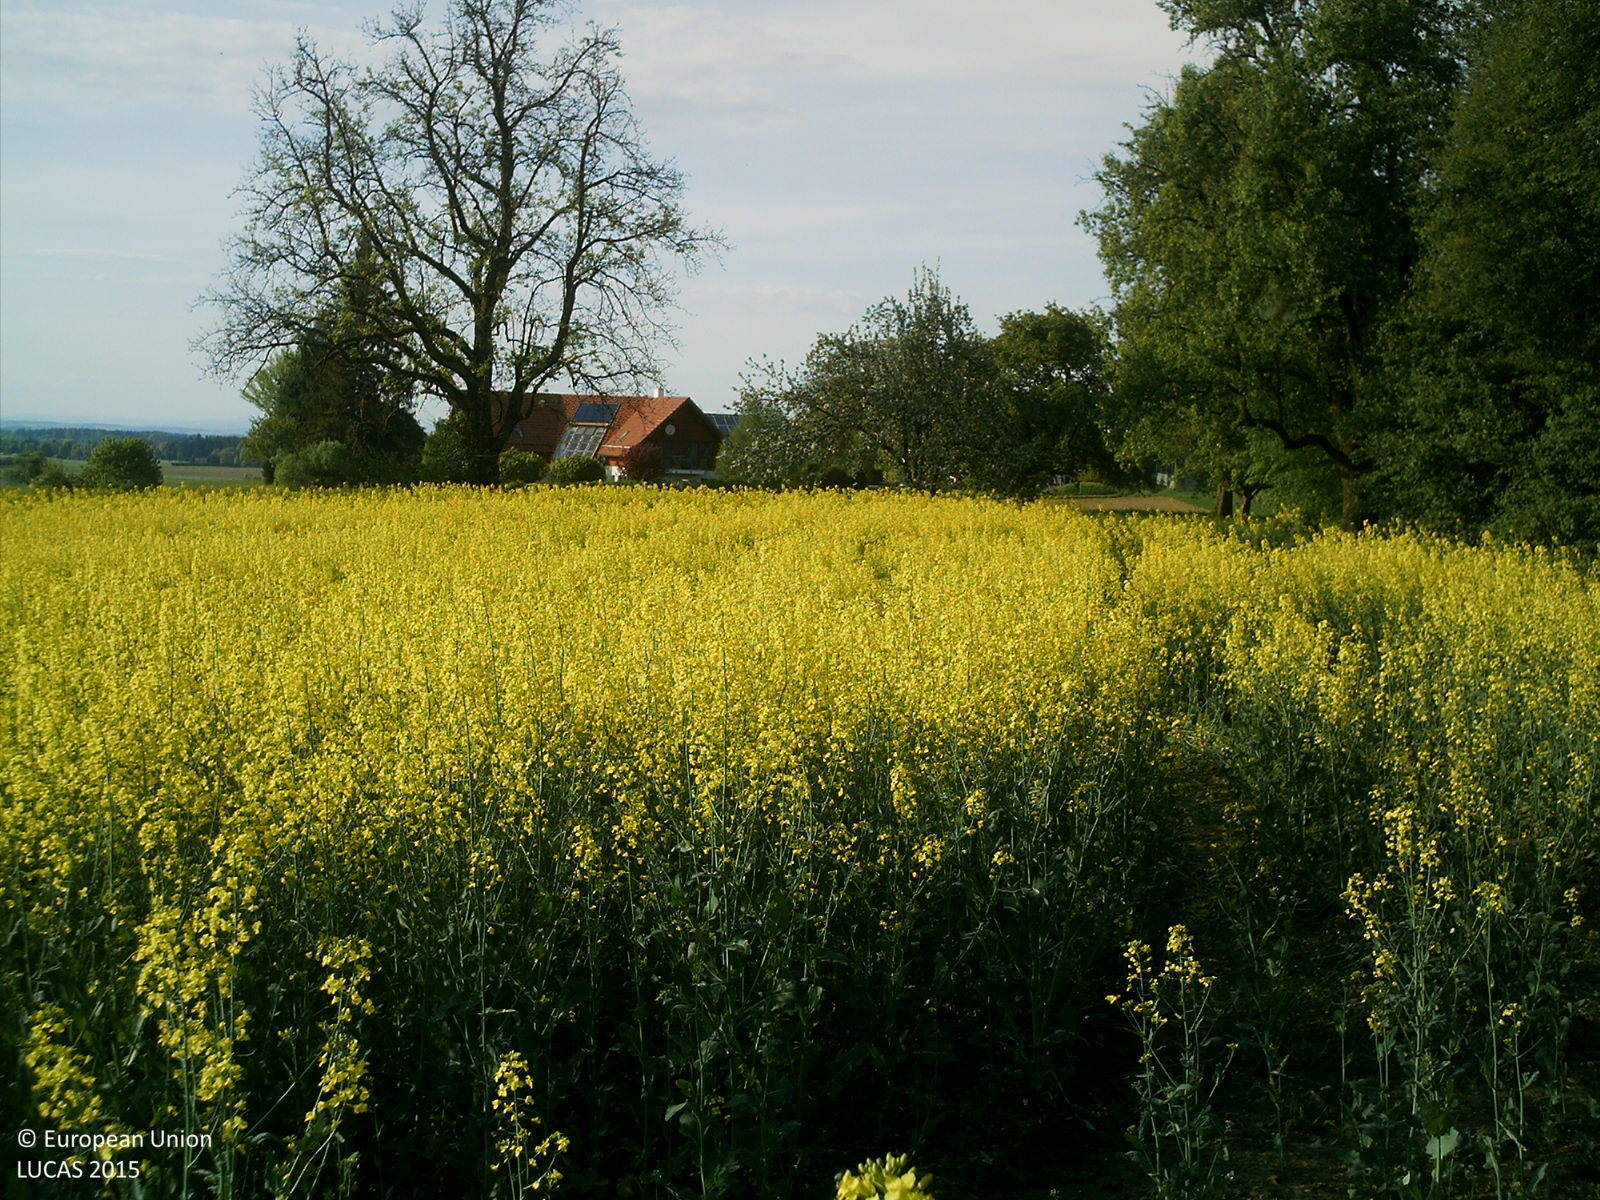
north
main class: Cropland
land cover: Rape and turnip rape
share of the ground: > 75 %
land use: Agriculture (excluding fallow land and kitchen gardens)
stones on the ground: < 10 %
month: May
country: AT
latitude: 47.9697
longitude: 14.0312
